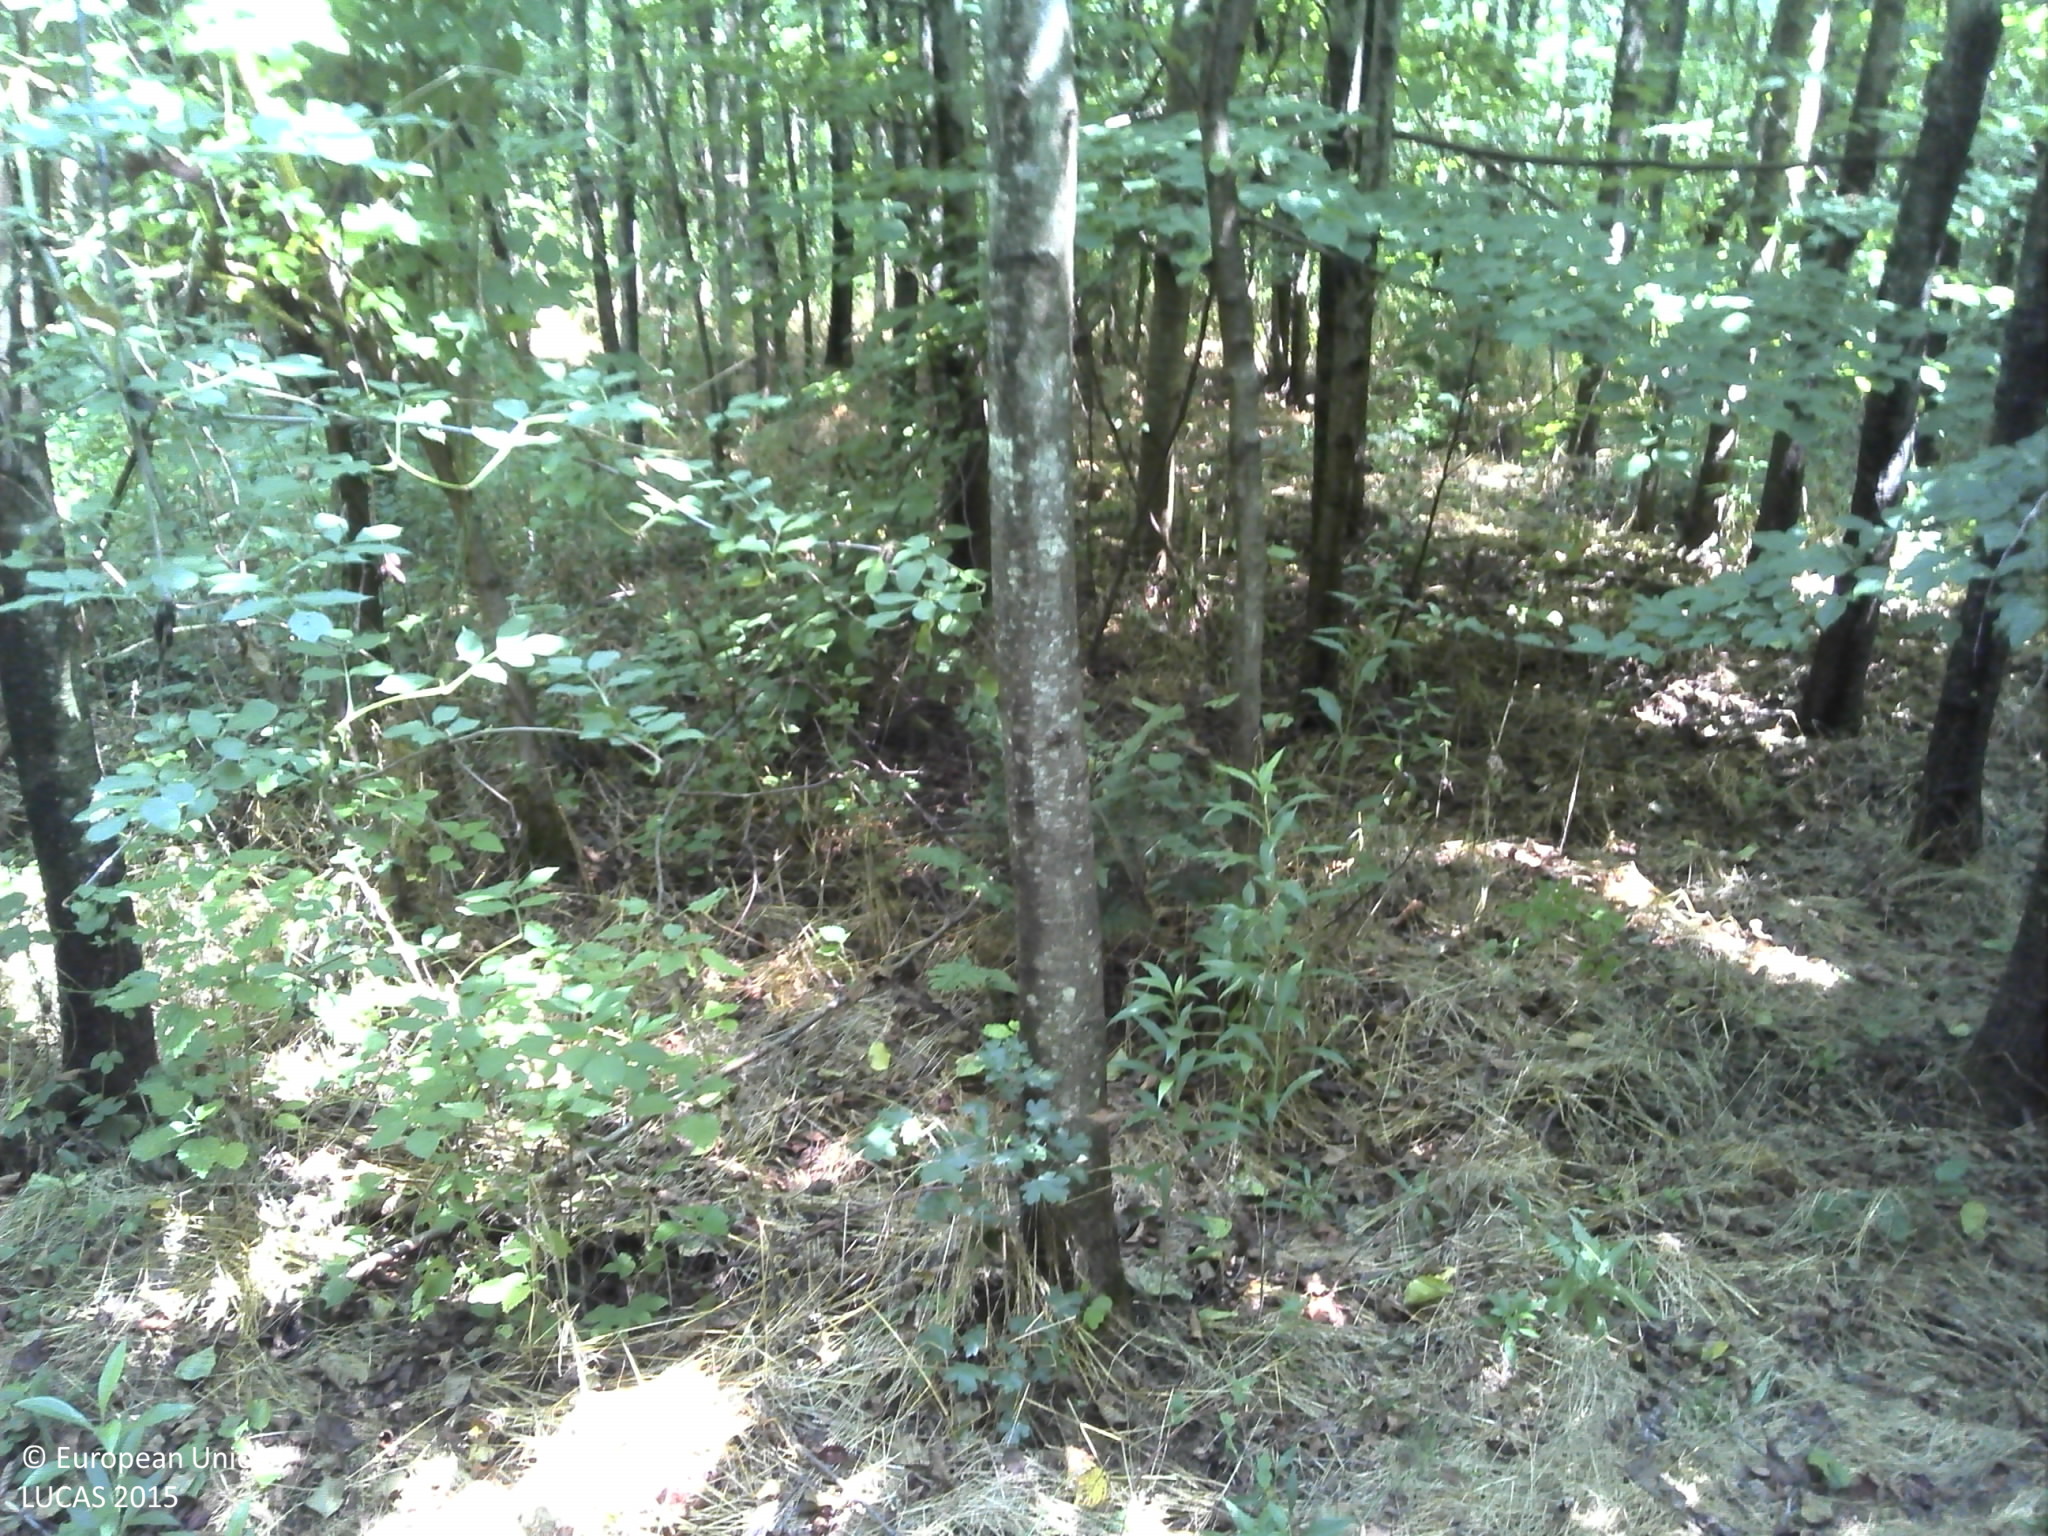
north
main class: Woodland
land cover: Broadleaved woodland
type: non-riverine alder, birch or aspen forest
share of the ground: > 75 %
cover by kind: broadleaved forest trees 90 %, shrubs 5 %, herbaceous plants 5 %
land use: Forestry
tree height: > 5 m
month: July
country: HR
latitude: 45.7681
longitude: 16.5959
